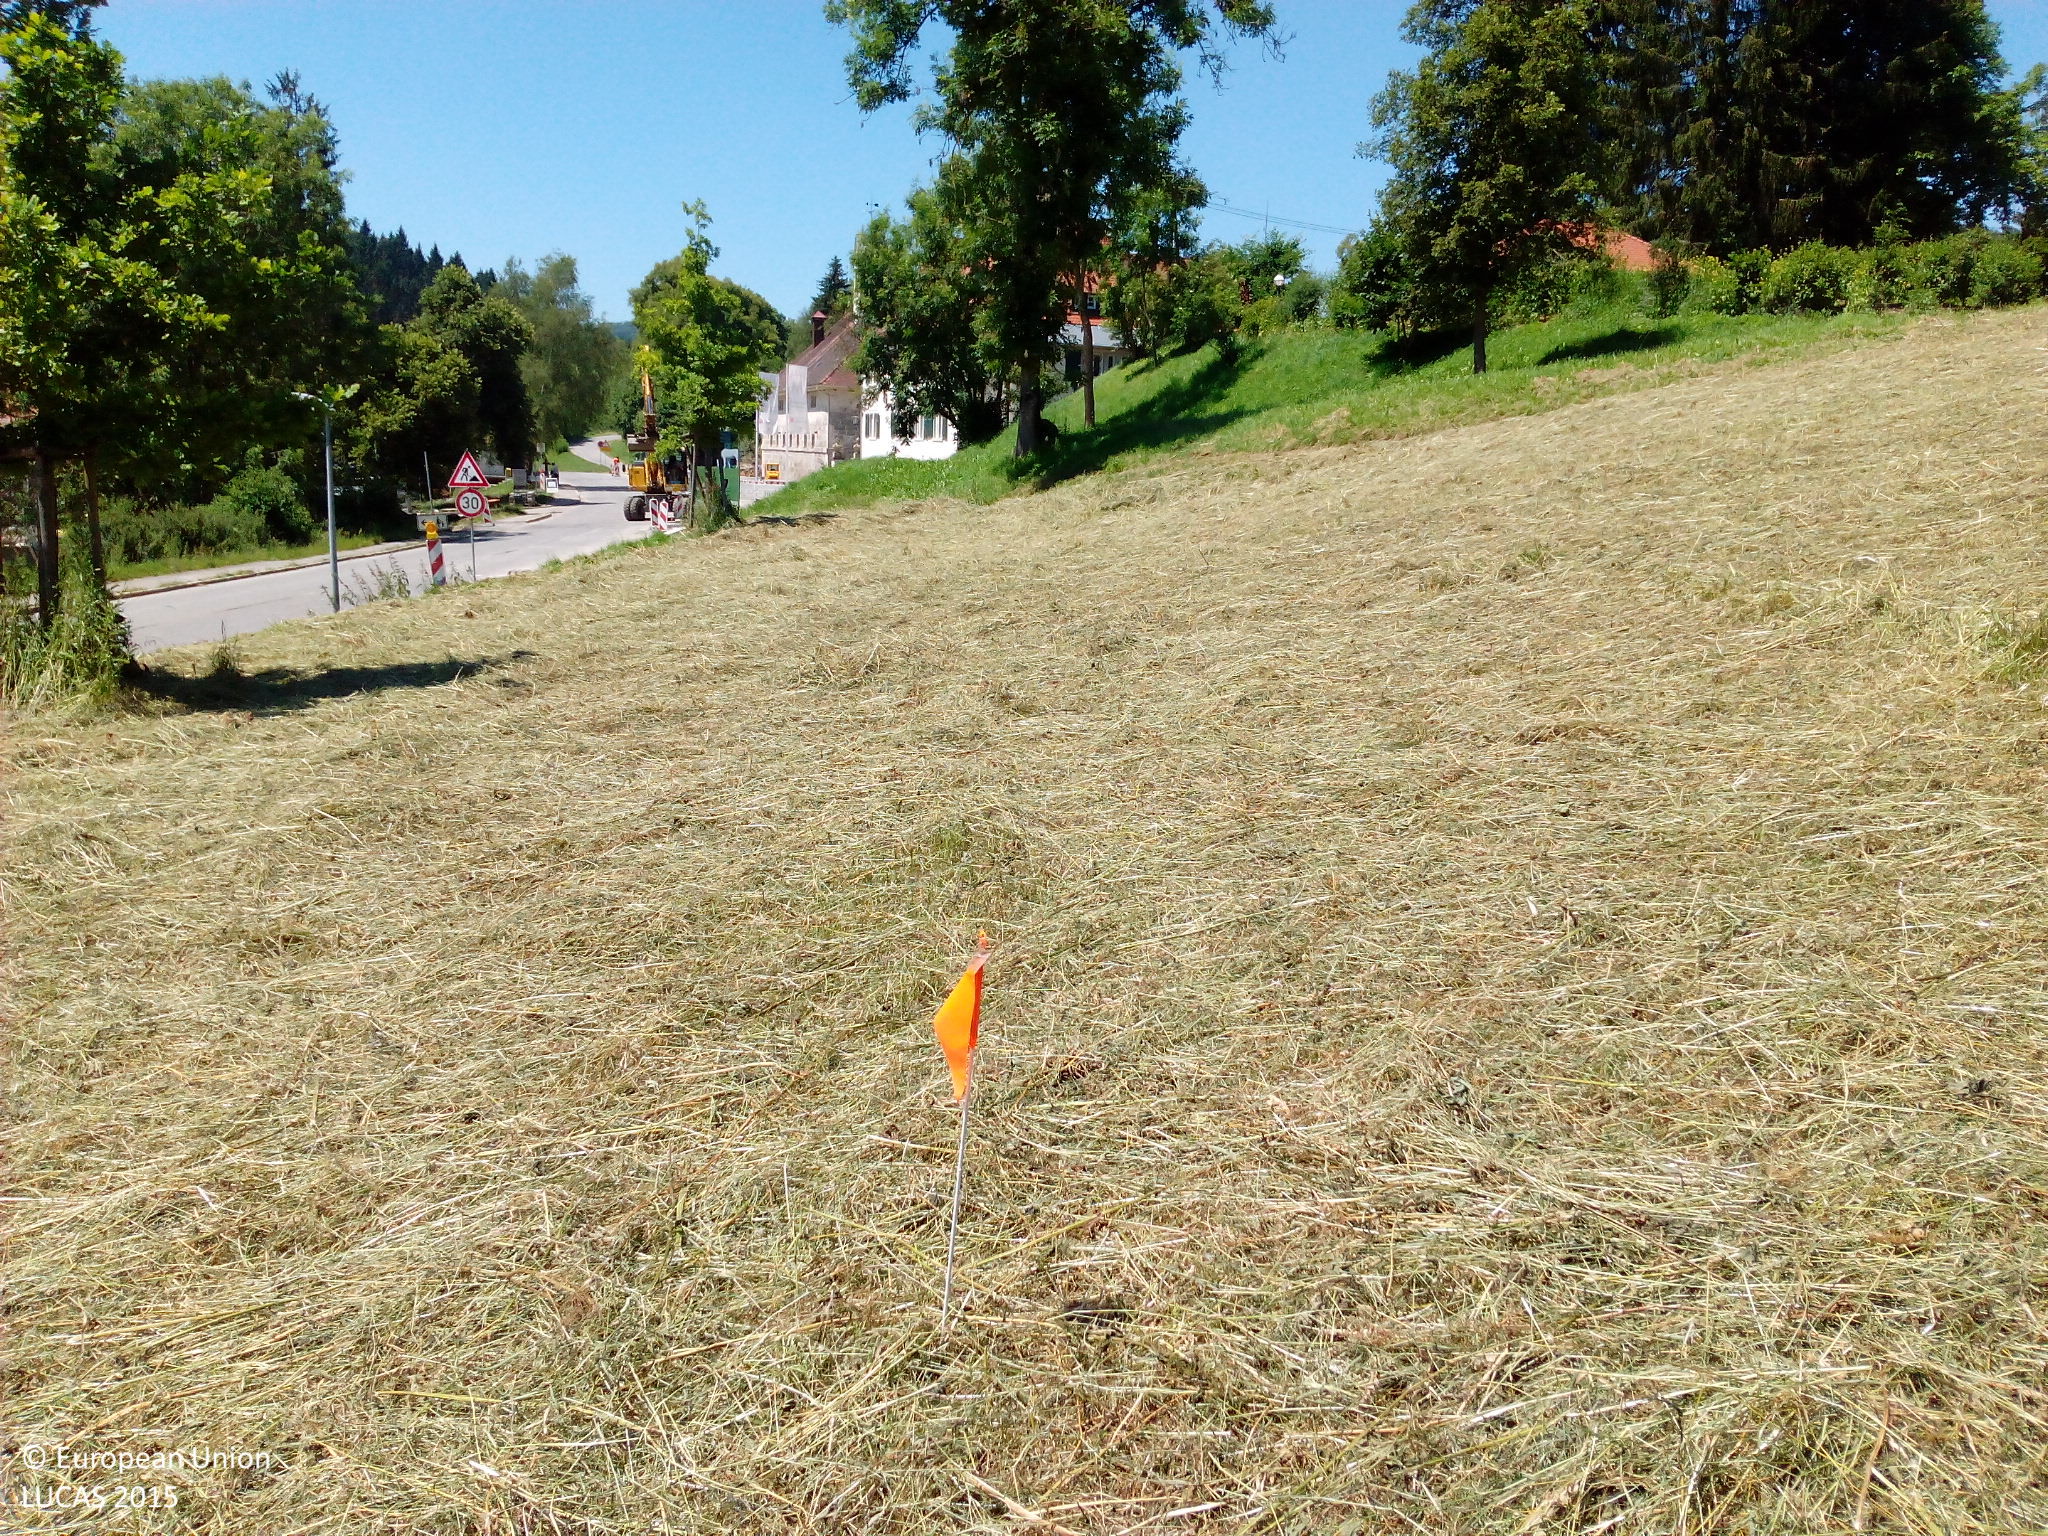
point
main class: Grassland
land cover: Grassland without tree/shrub cover
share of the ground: > 75 %
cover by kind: herbaceous plants 100 %
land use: Agriculture (excluding fallow land and kitchen gardens)
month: July
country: DE
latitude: 48.3840
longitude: 9.4197
